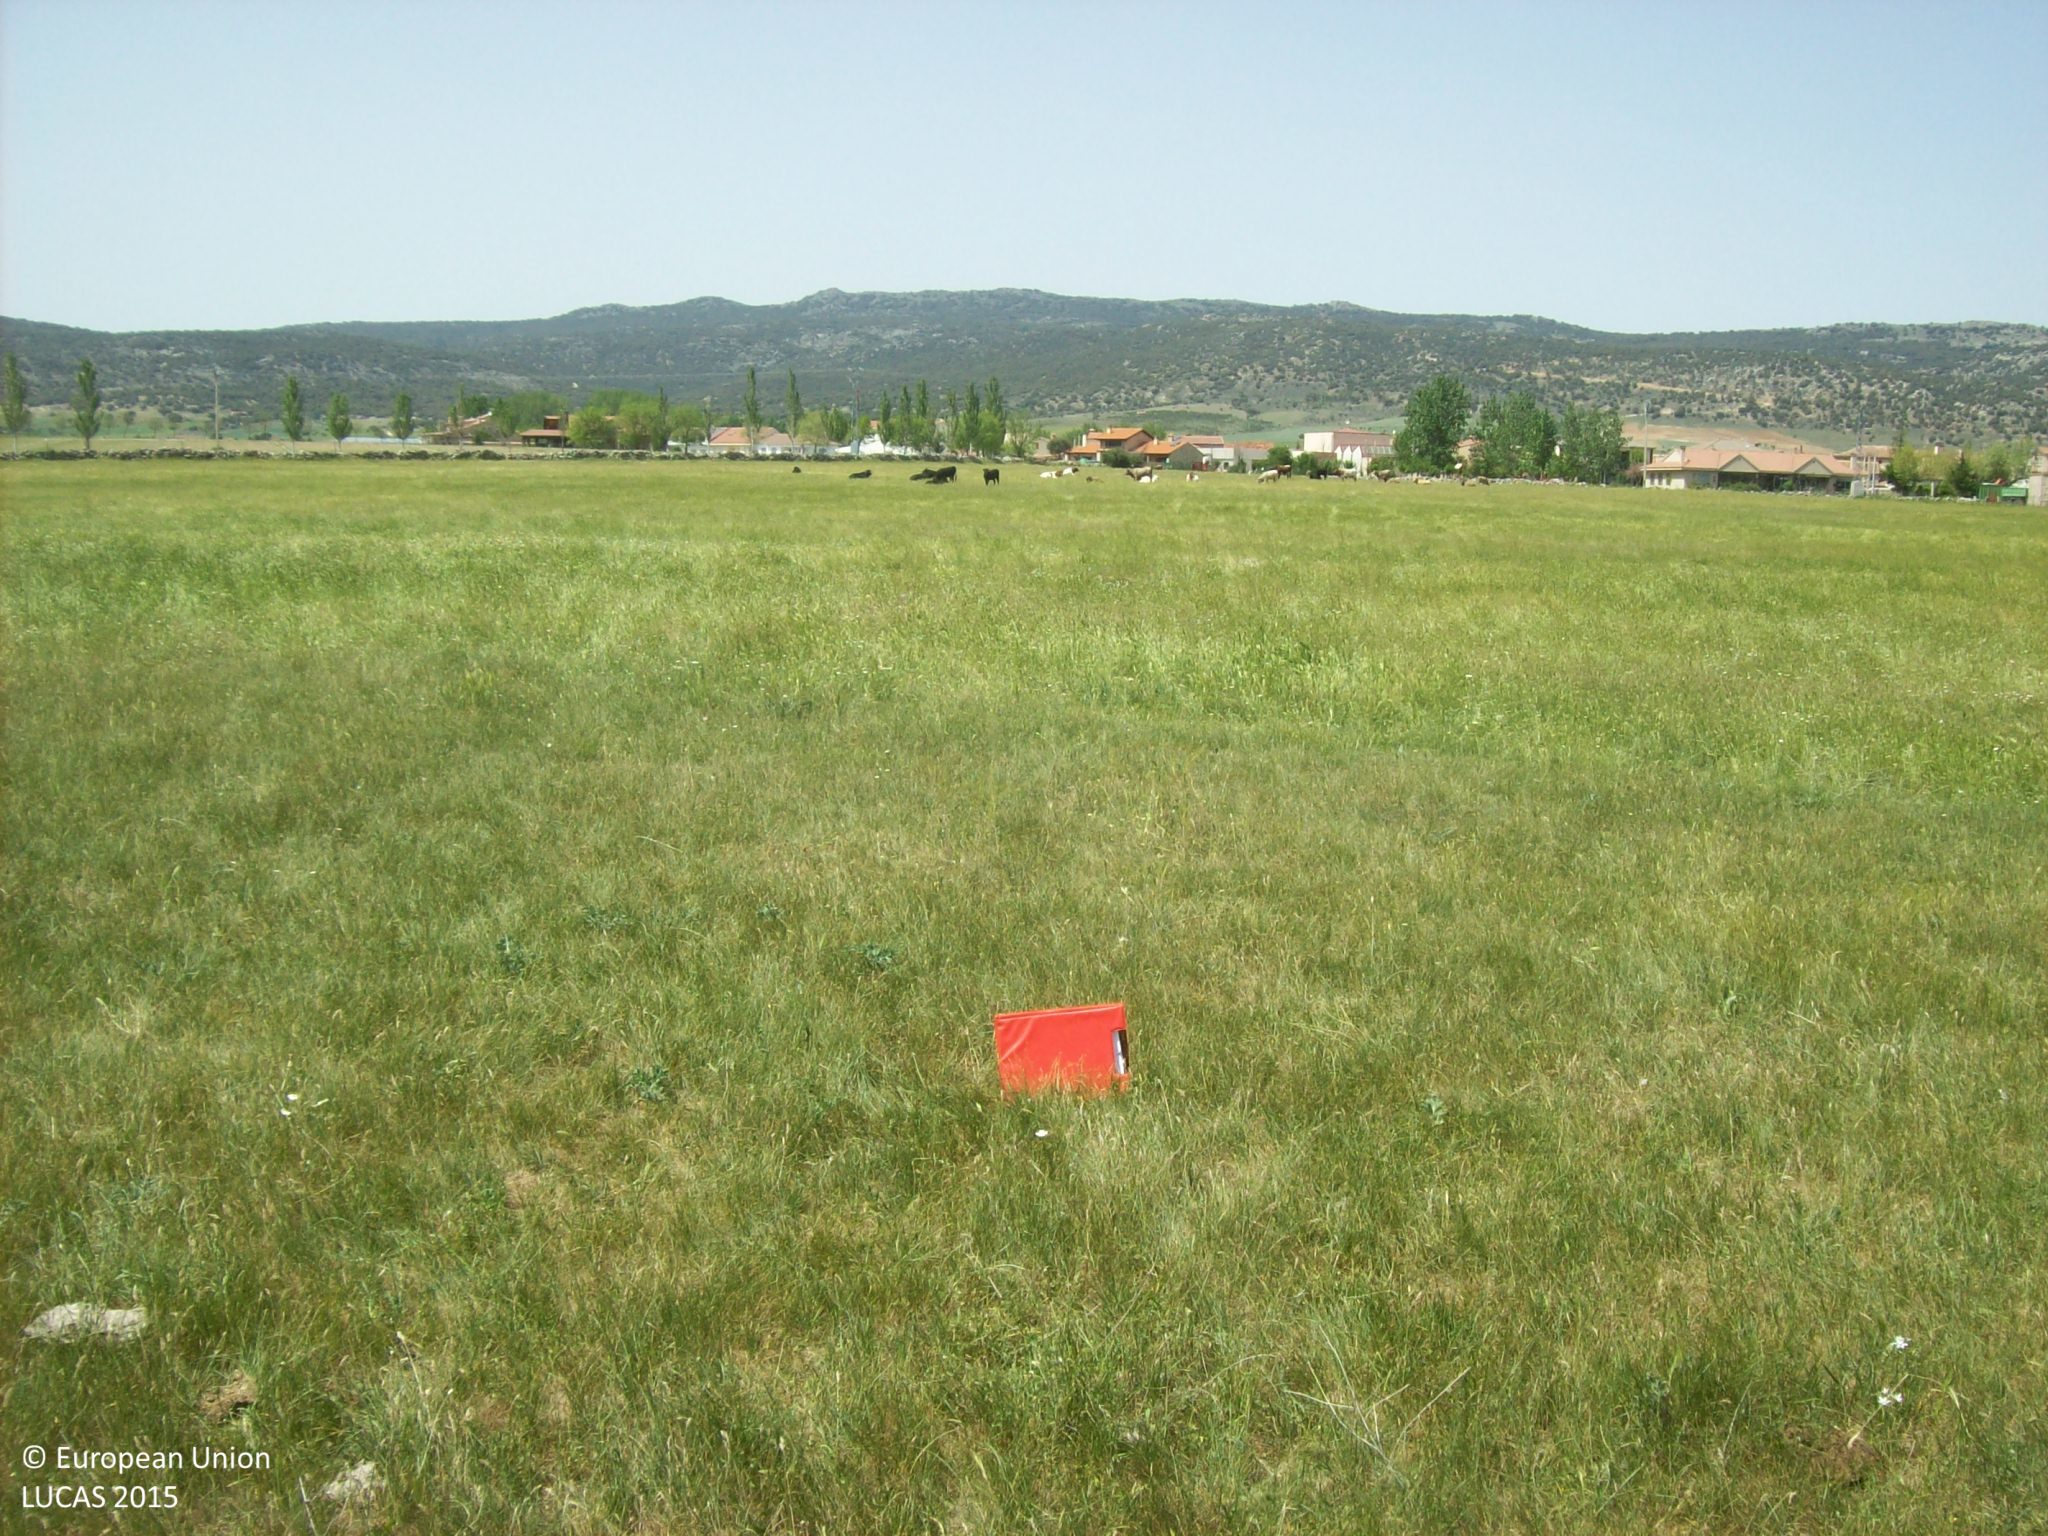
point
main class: Grassland
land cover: Grassland without tree/shrub cover
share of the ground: > 75 %
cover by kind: herbaceous plants 100 %
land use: Agriculture (excluding fallow land and kitchen gardens)
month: May
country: ES
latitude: 40.6178
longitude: -4.8448
